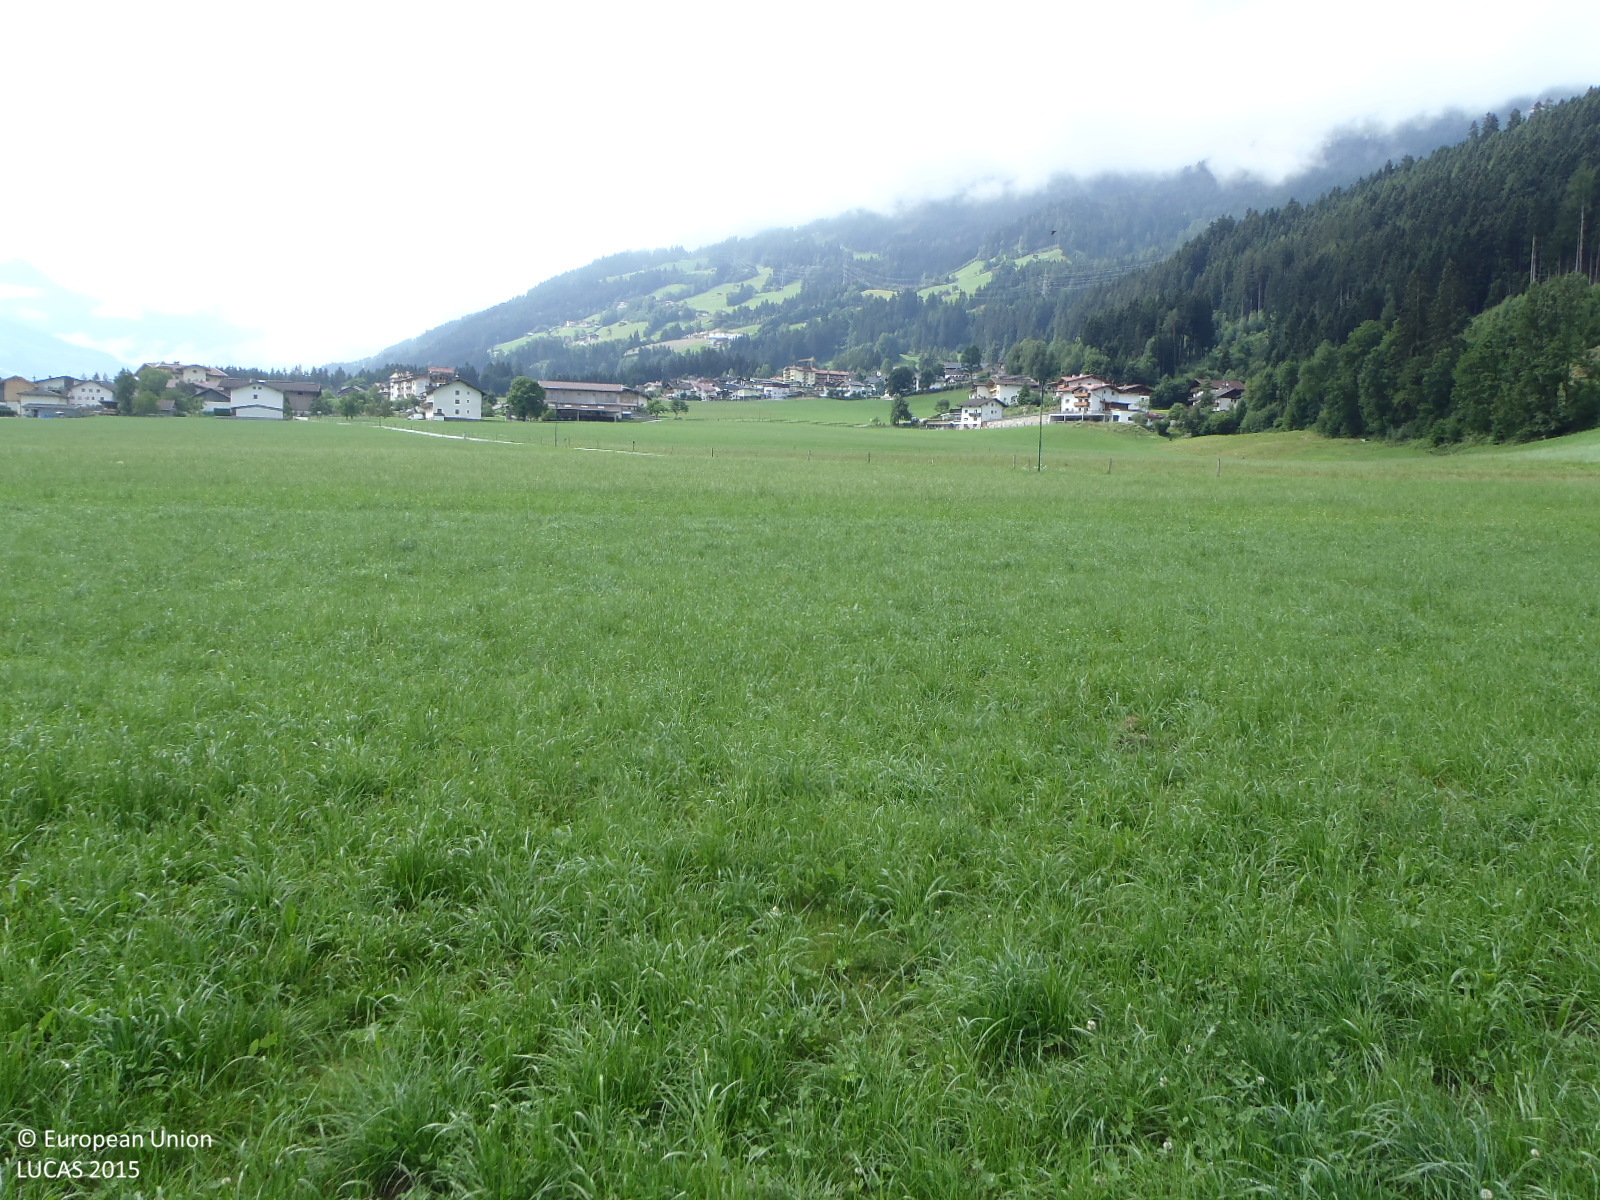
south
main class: Grassland
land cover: Grassland without tree/shrub cover
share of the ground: > 75 %
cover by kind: herbaceous plants 100 %
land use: Agriculture (excluding fallow land and kitchen gardens)
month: July
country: AT
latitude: 47.3076
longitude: 11.8635
